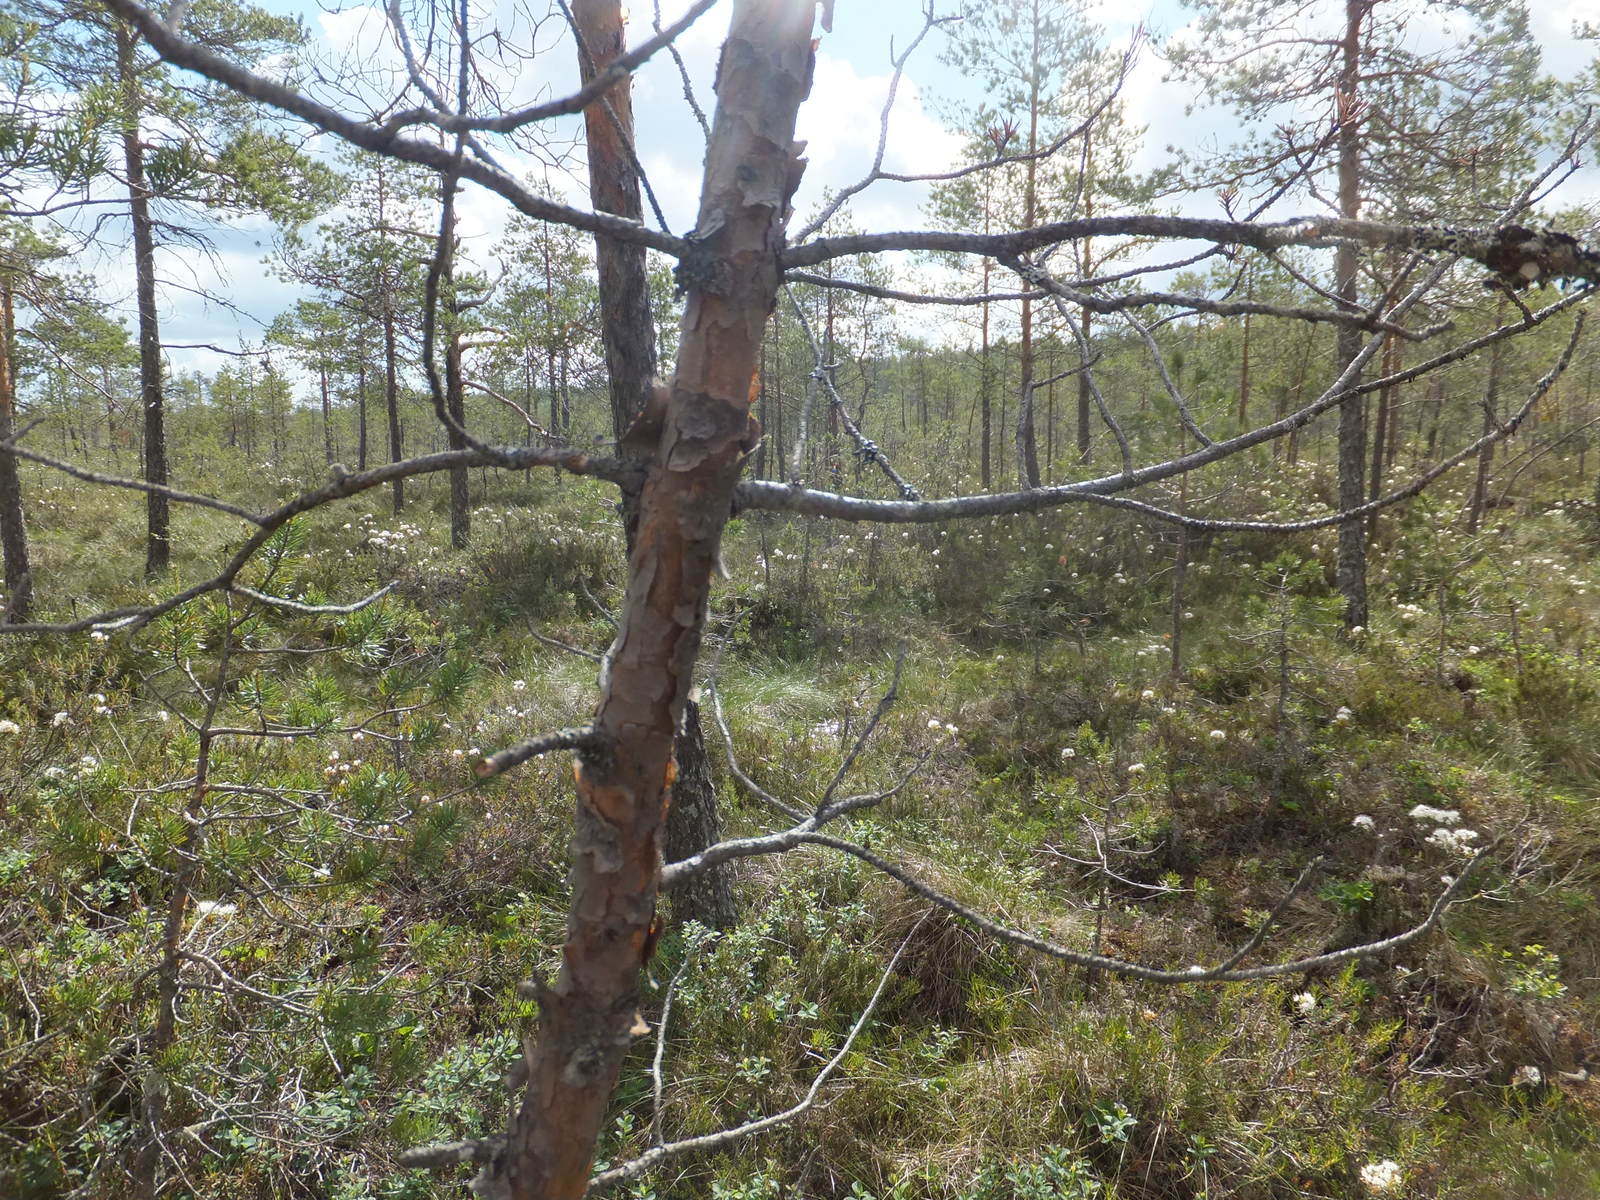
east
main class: Woodland
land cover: Pine dominated coniferous woodland
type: mire and swamp forests
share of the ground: > 75 %
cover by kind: coniferous forest trees 75 %, shrubs 10 %, herbaceous plants 10 %, lichens and mosses 5 %
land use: Forestry
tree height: < 5 m
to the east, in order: Pine dominated coniferous woodland; Peatbogs; Pine dominated coniferous woodland
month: June
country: FI
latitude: 63.4033
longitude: 24.0260
